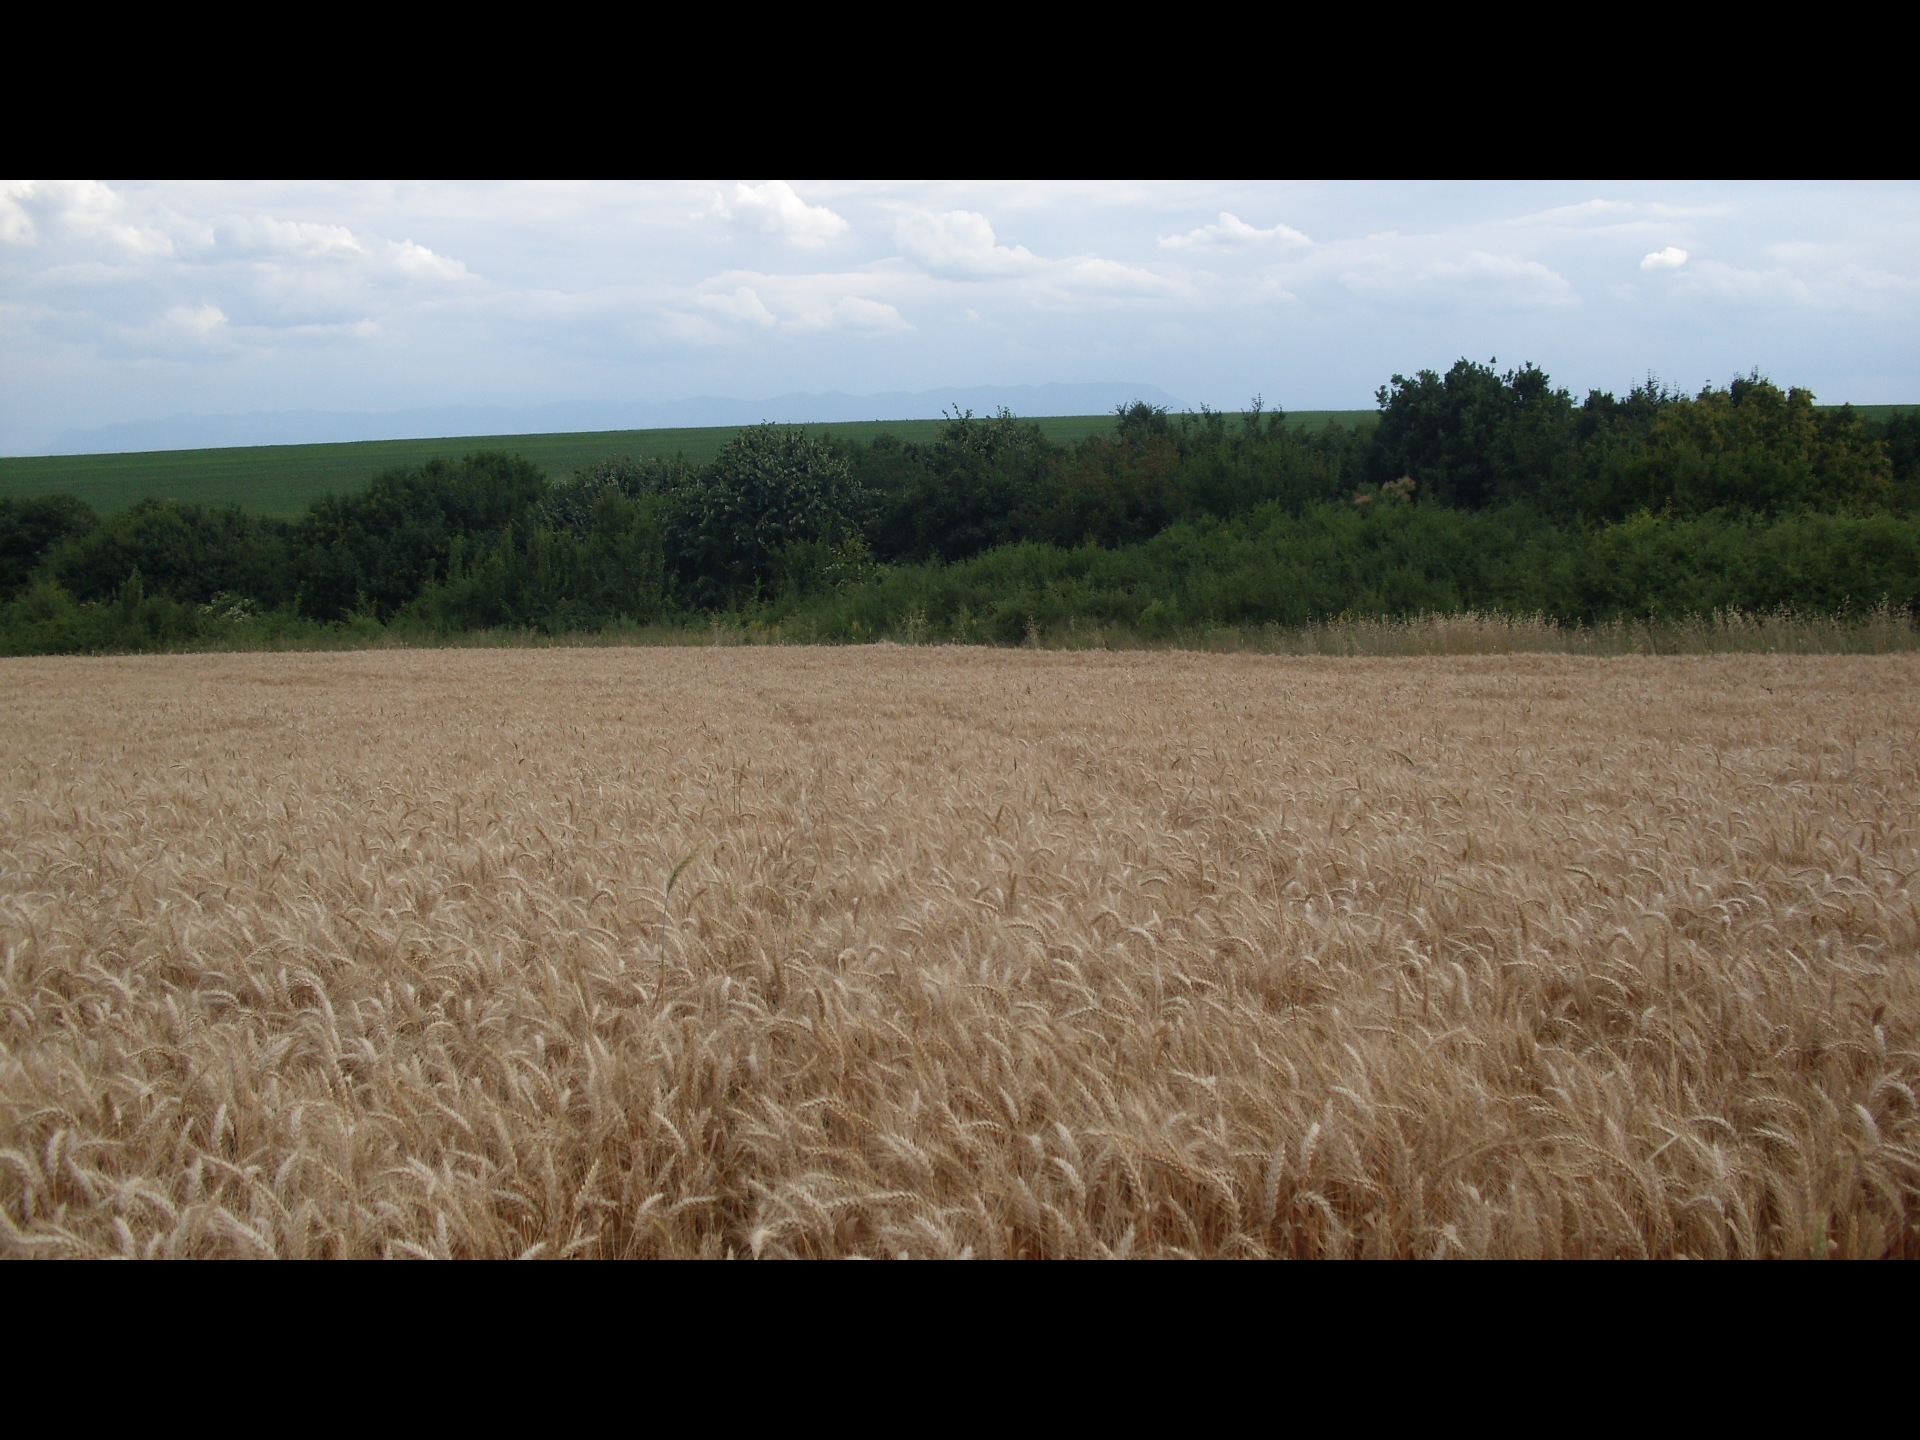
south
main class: Cropland
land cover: Common wheat
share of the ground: > 75 %
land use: Agriculture (excluding fallow land and kitchen gardens)
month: June
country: BG
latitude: 43.4631
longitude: 23.5044
